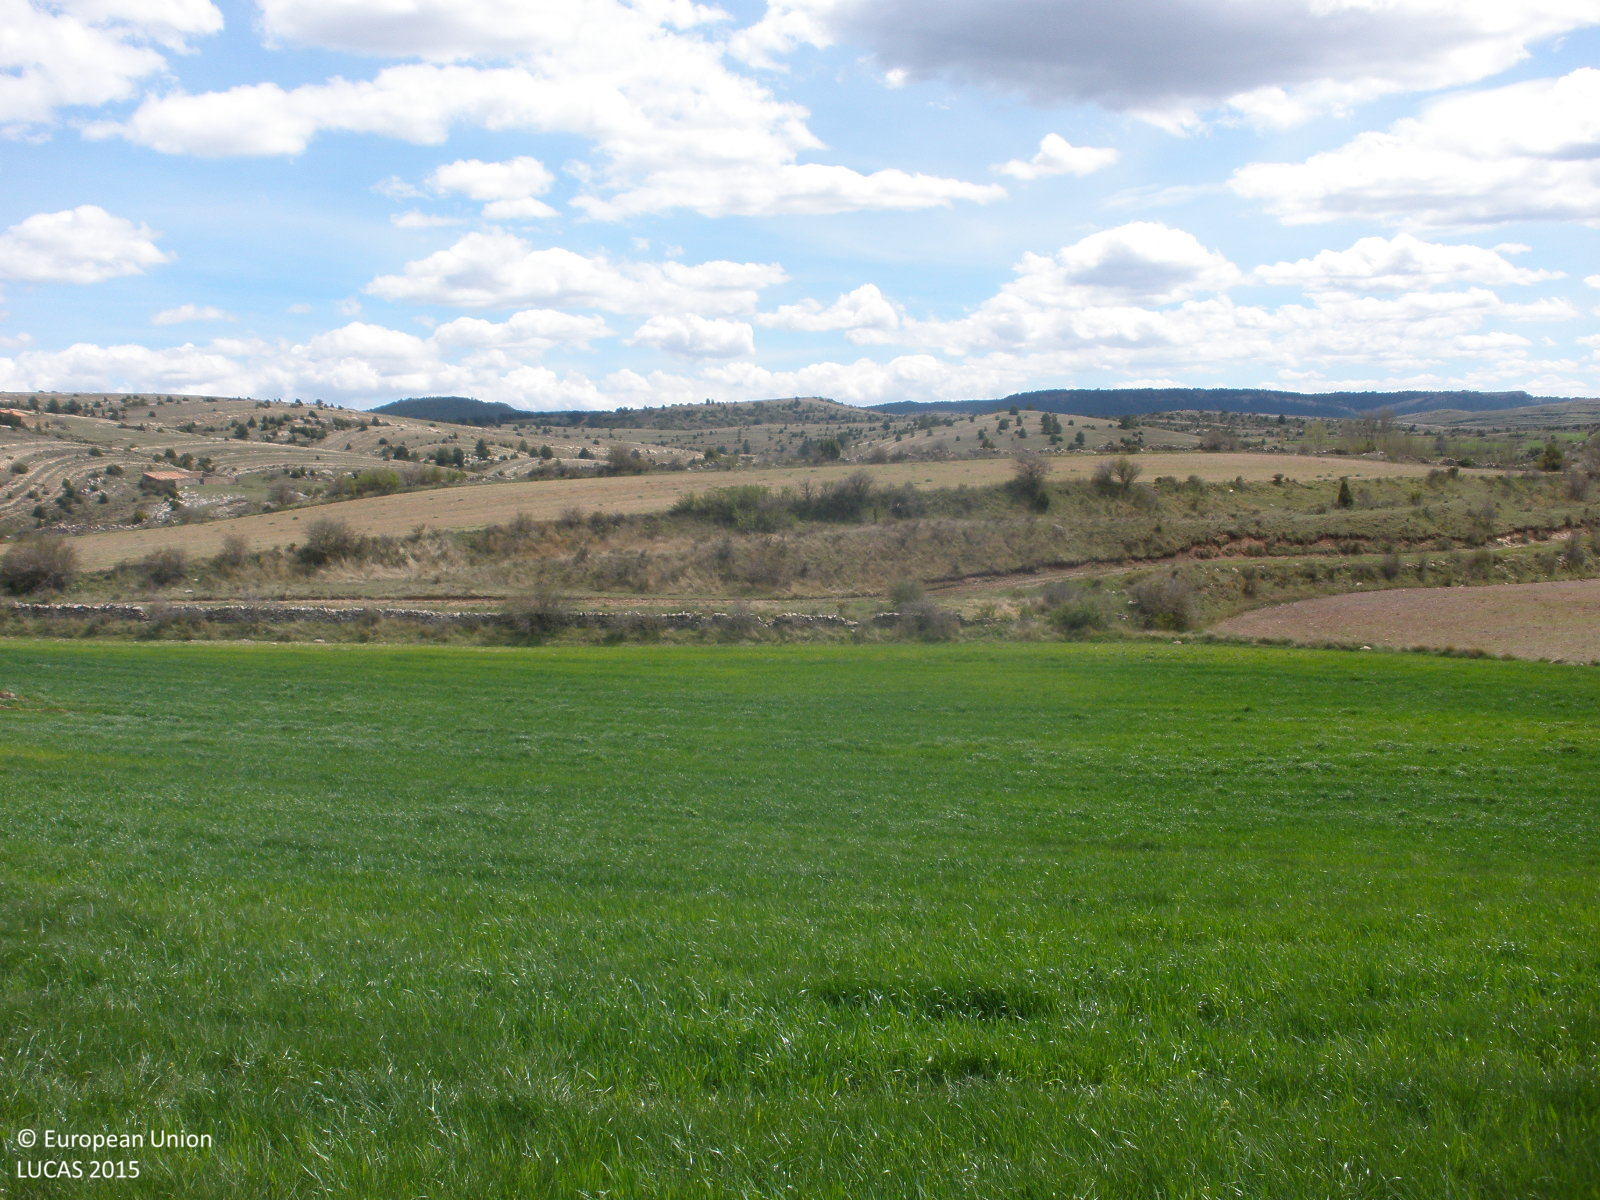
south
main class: Cropland
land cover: Barley
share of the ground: > 75 %
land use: Agriculture (excluding fallow land and kitchen gardens)
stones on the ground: 10 - 25 %
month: April
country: ES
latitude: 40.4510
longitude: -0.8223
